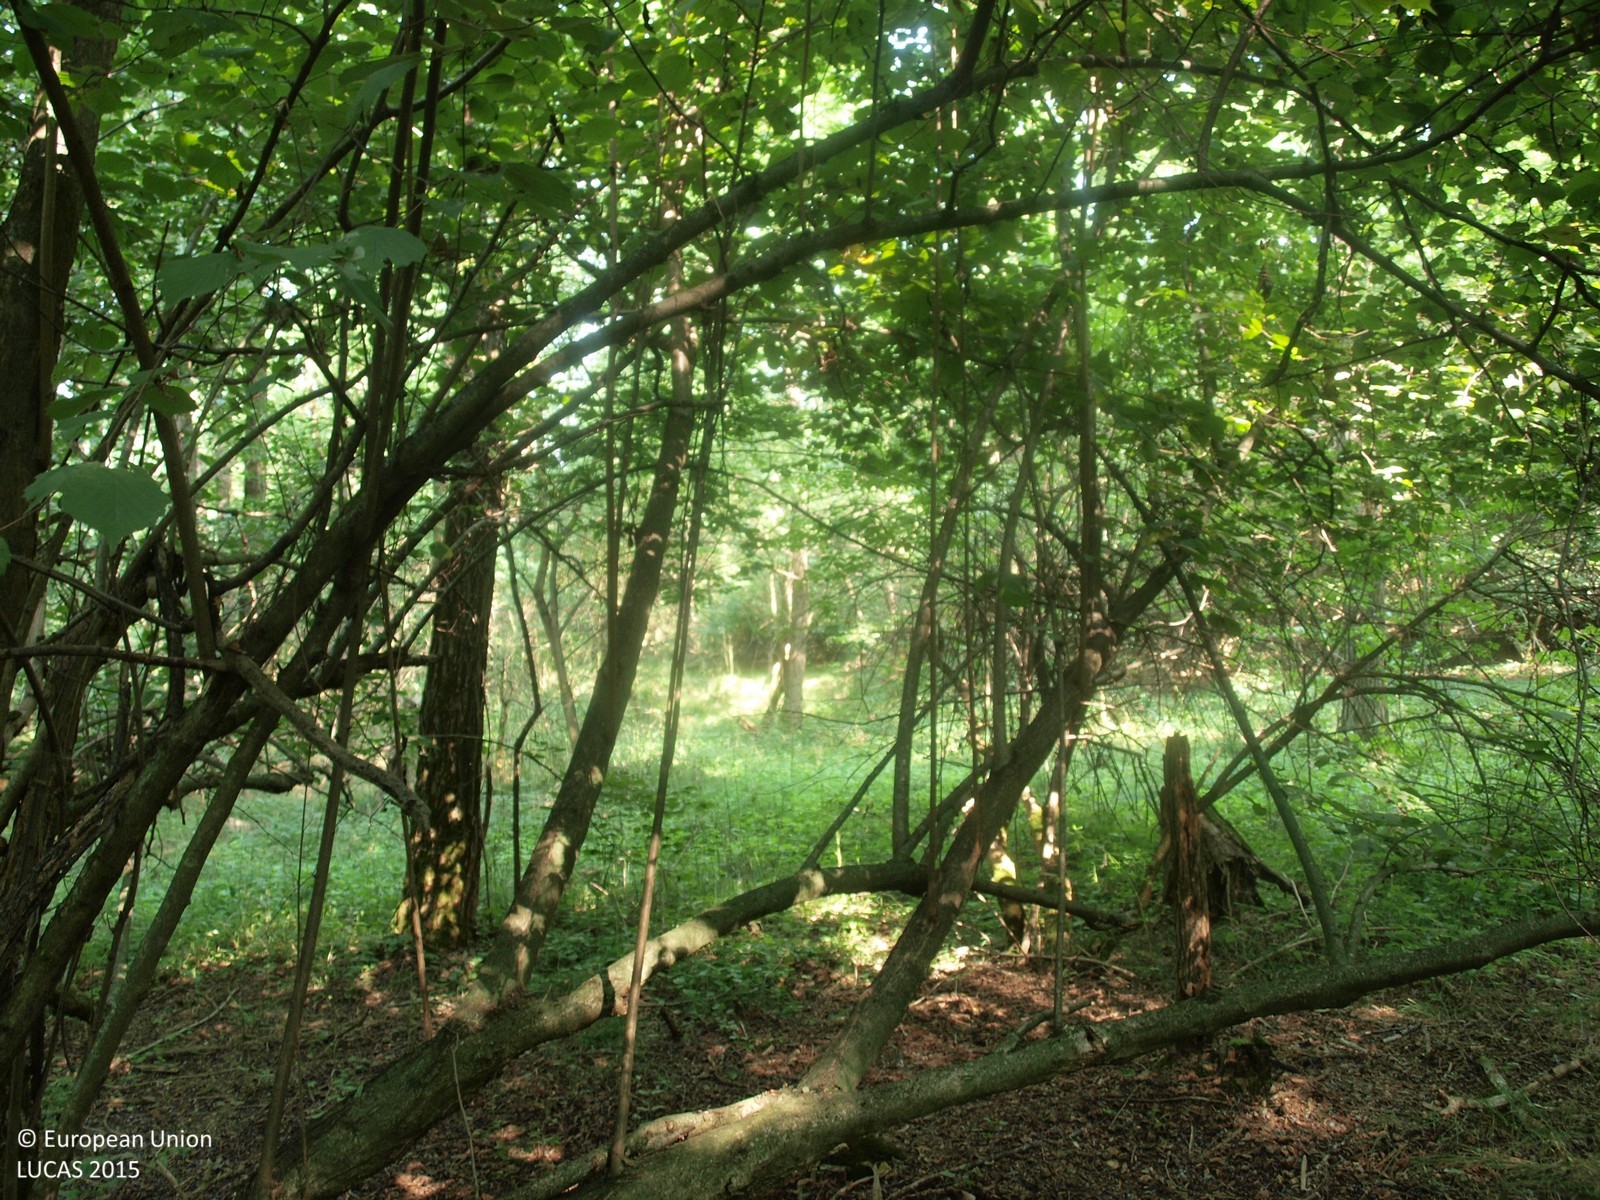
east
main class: Woodland
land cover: Broadleaved woodland
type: mesophytic deciduous forest
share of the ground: > 75 %
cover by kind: broadleaved forest trees 100 %
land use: Forestry
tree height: > 5 m
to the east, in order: Broadleaved woodland; Rivers and streams; Broadleaved woodland; Grassland without tree/shrub cover; Single bushes/trees; Grassland without tree/shrub cover
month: August
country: HR
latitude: 45.9621
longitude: 16.6713
